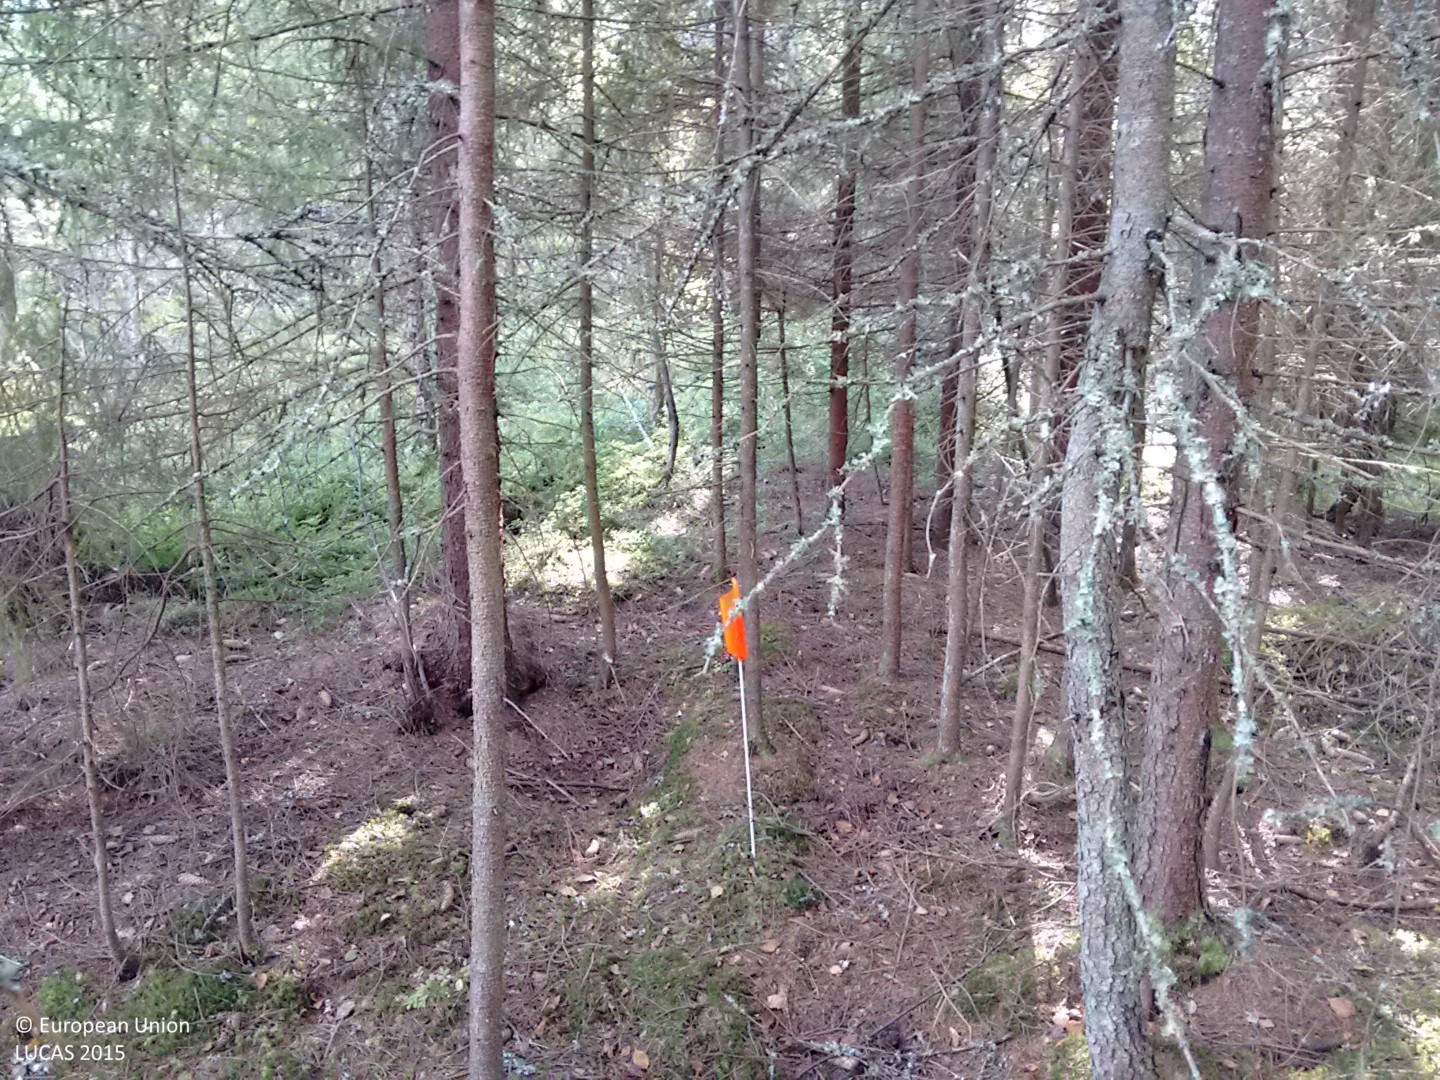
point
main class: Woodland
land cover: Spruce dominated coniferous woodland
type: hemiboreal forest and nemoral coniferous forest and mixed broadleaved-coniferous forest
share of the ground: > 75 %
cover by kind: coniferous forest trees 100 %
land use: Forestry
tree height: > 5 m
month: September
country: FI
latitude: 61.0497
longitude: 21.3674
